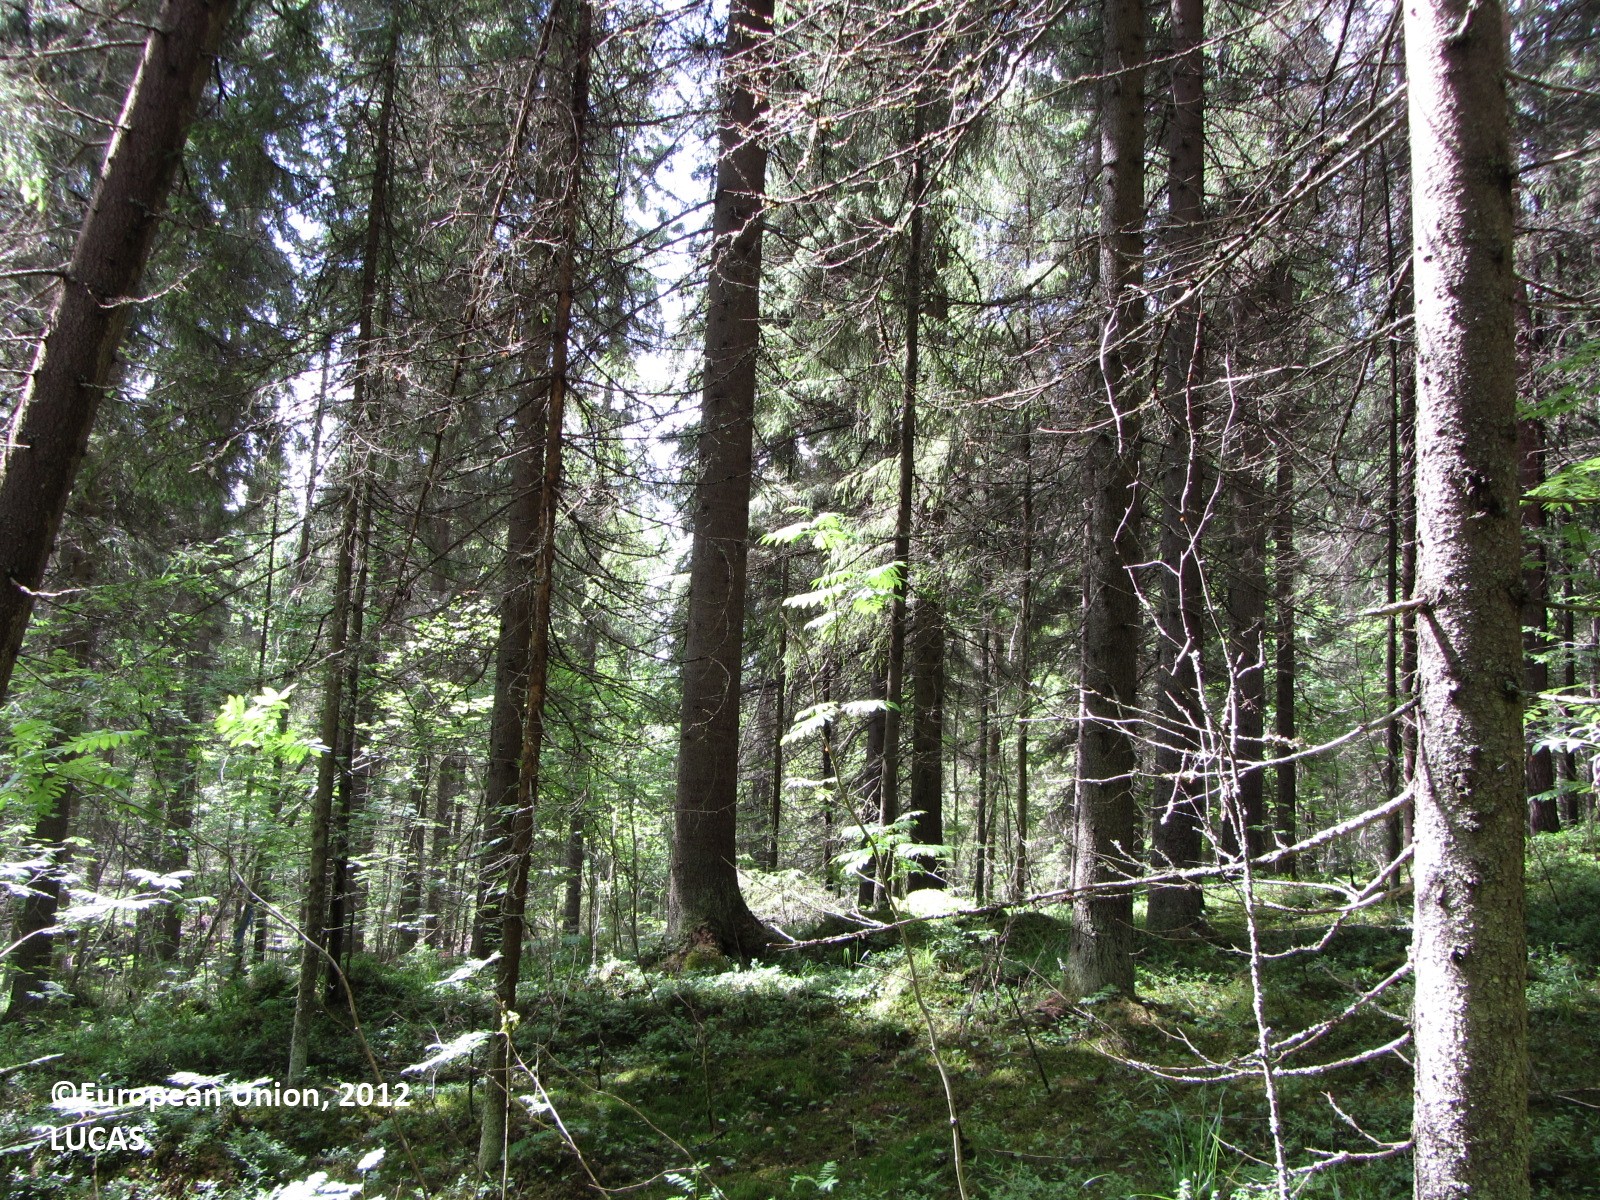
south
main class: Woodland
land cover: Spruce dominated coniferous woodland
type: boreal forest
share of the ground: > 75 %
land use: Forestry
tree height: > 5 m
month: June
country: FI
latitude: 61.9907
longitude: 25.2865
